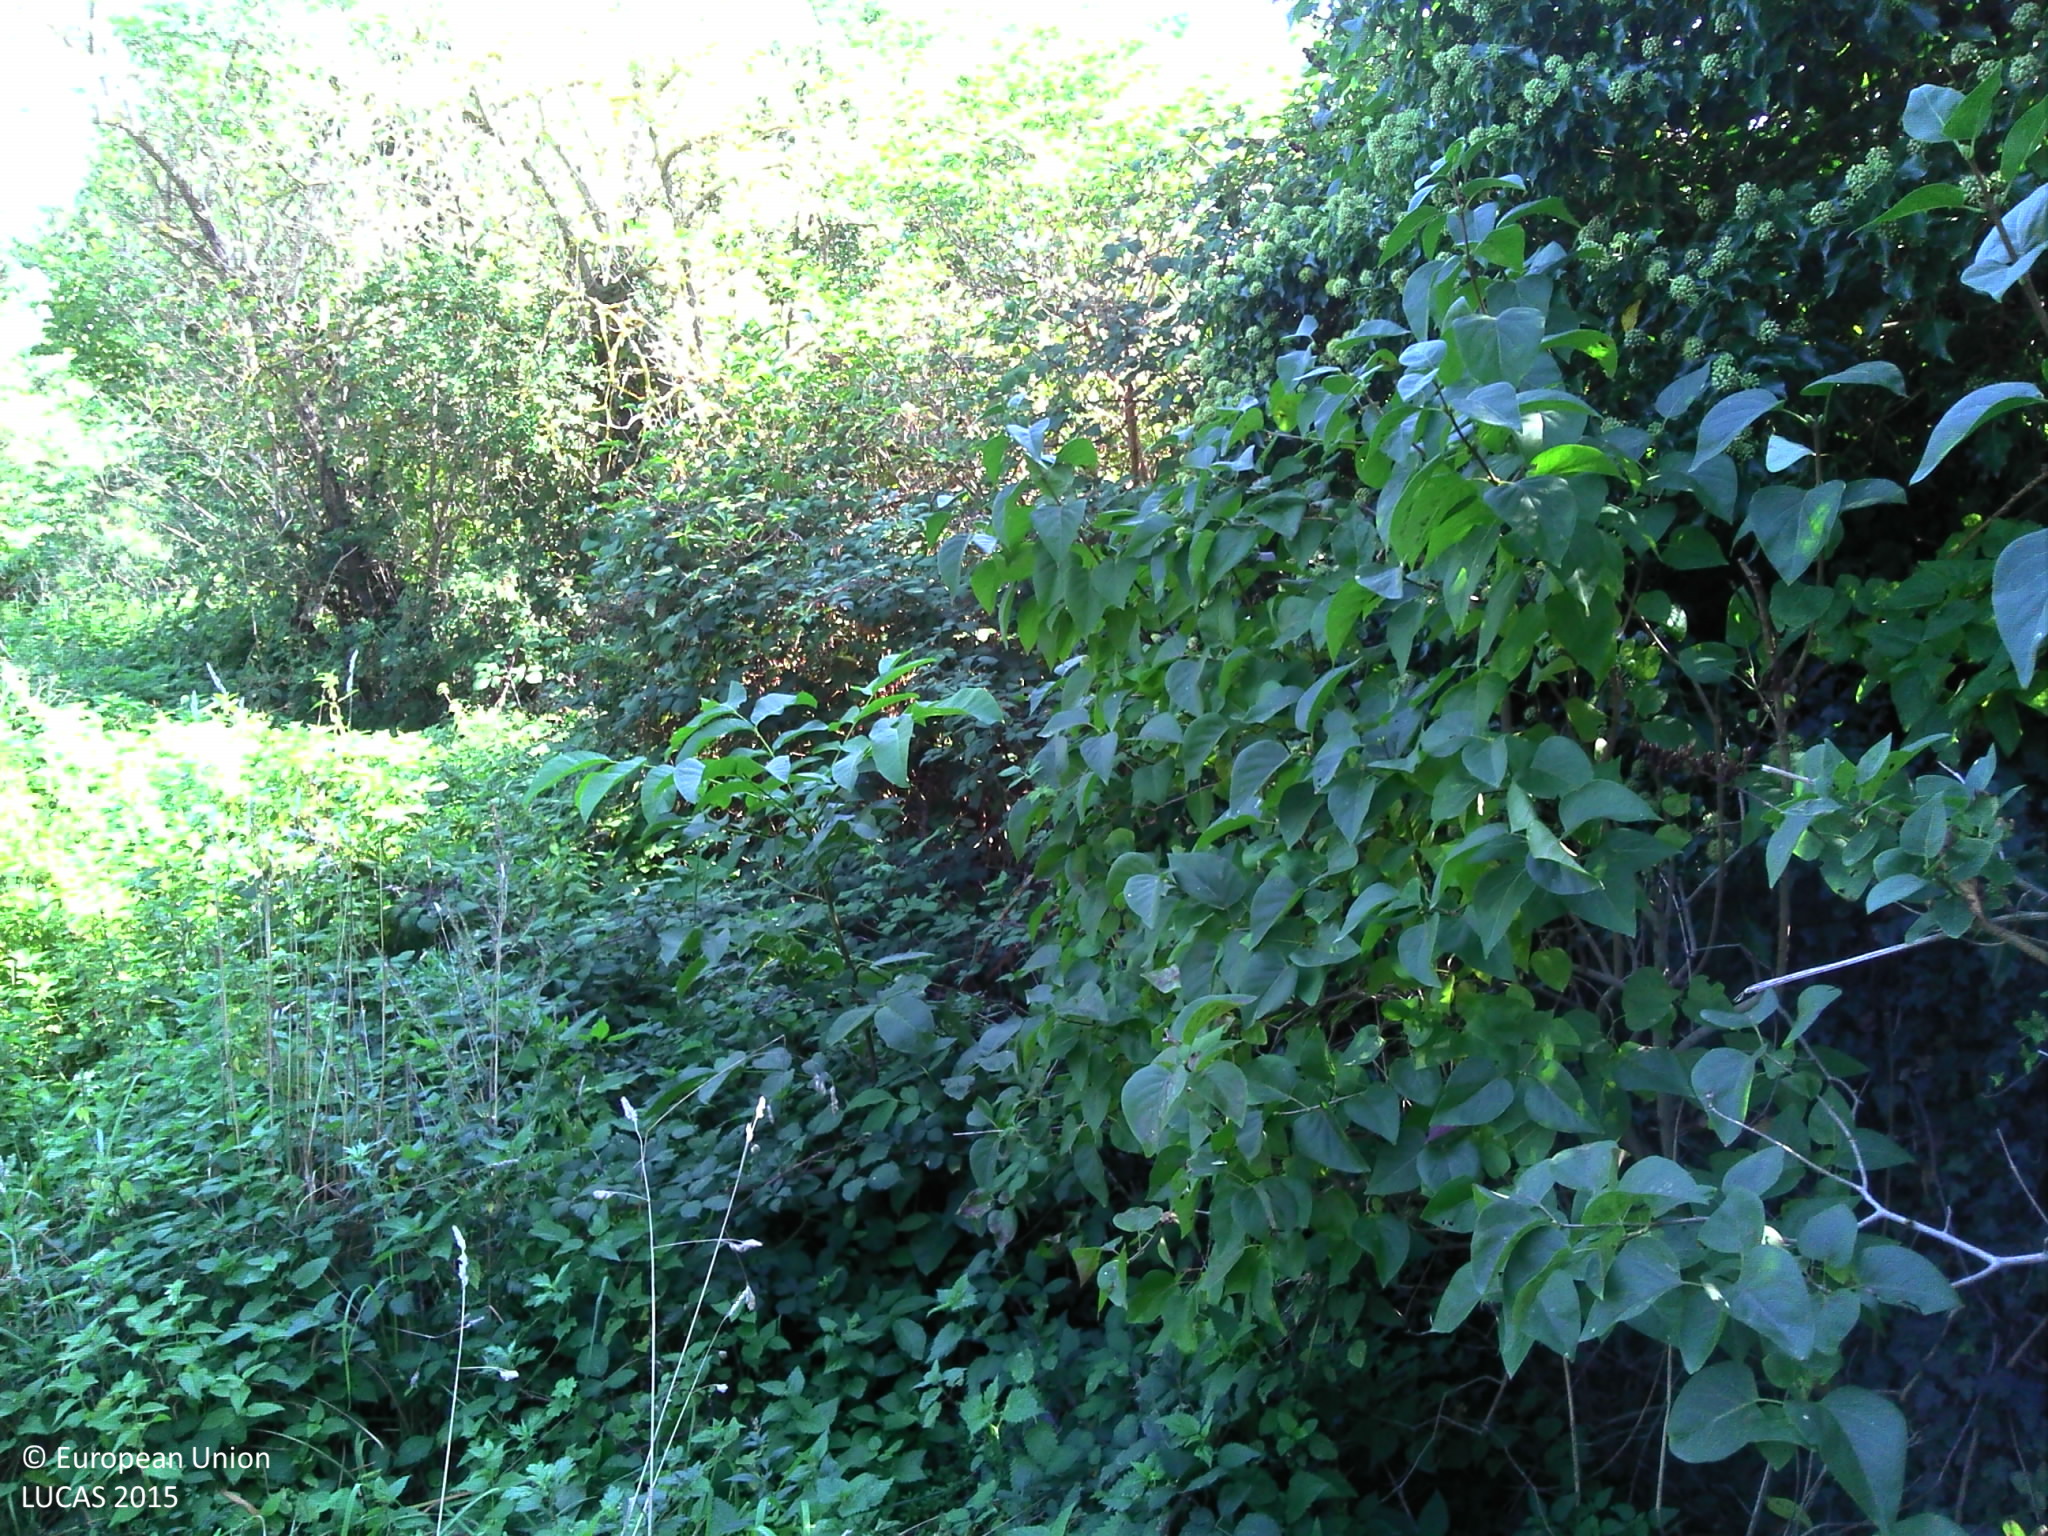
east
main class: Grassland
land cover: Grassland without tree/shrub cover
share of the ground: > 75 %
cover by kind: herbaceous plants 100 %
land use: Agriculture (excluding fallow land and kitchen gardens)
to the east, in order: Grassland without tree/shrub cover; Other bare soil; Vineyards; Fences; Other fresh vegetables; Grass margins; Managed hedges; Grassland without tree/shrub cover; Broadleaved woodland; Grassland without tree/shrub cover; Artificial constructions in urban areas; Broadleaved woodland; Grassland without tree/shrub cover
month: October
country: FR
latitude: 45.8902
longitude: 3.0531
